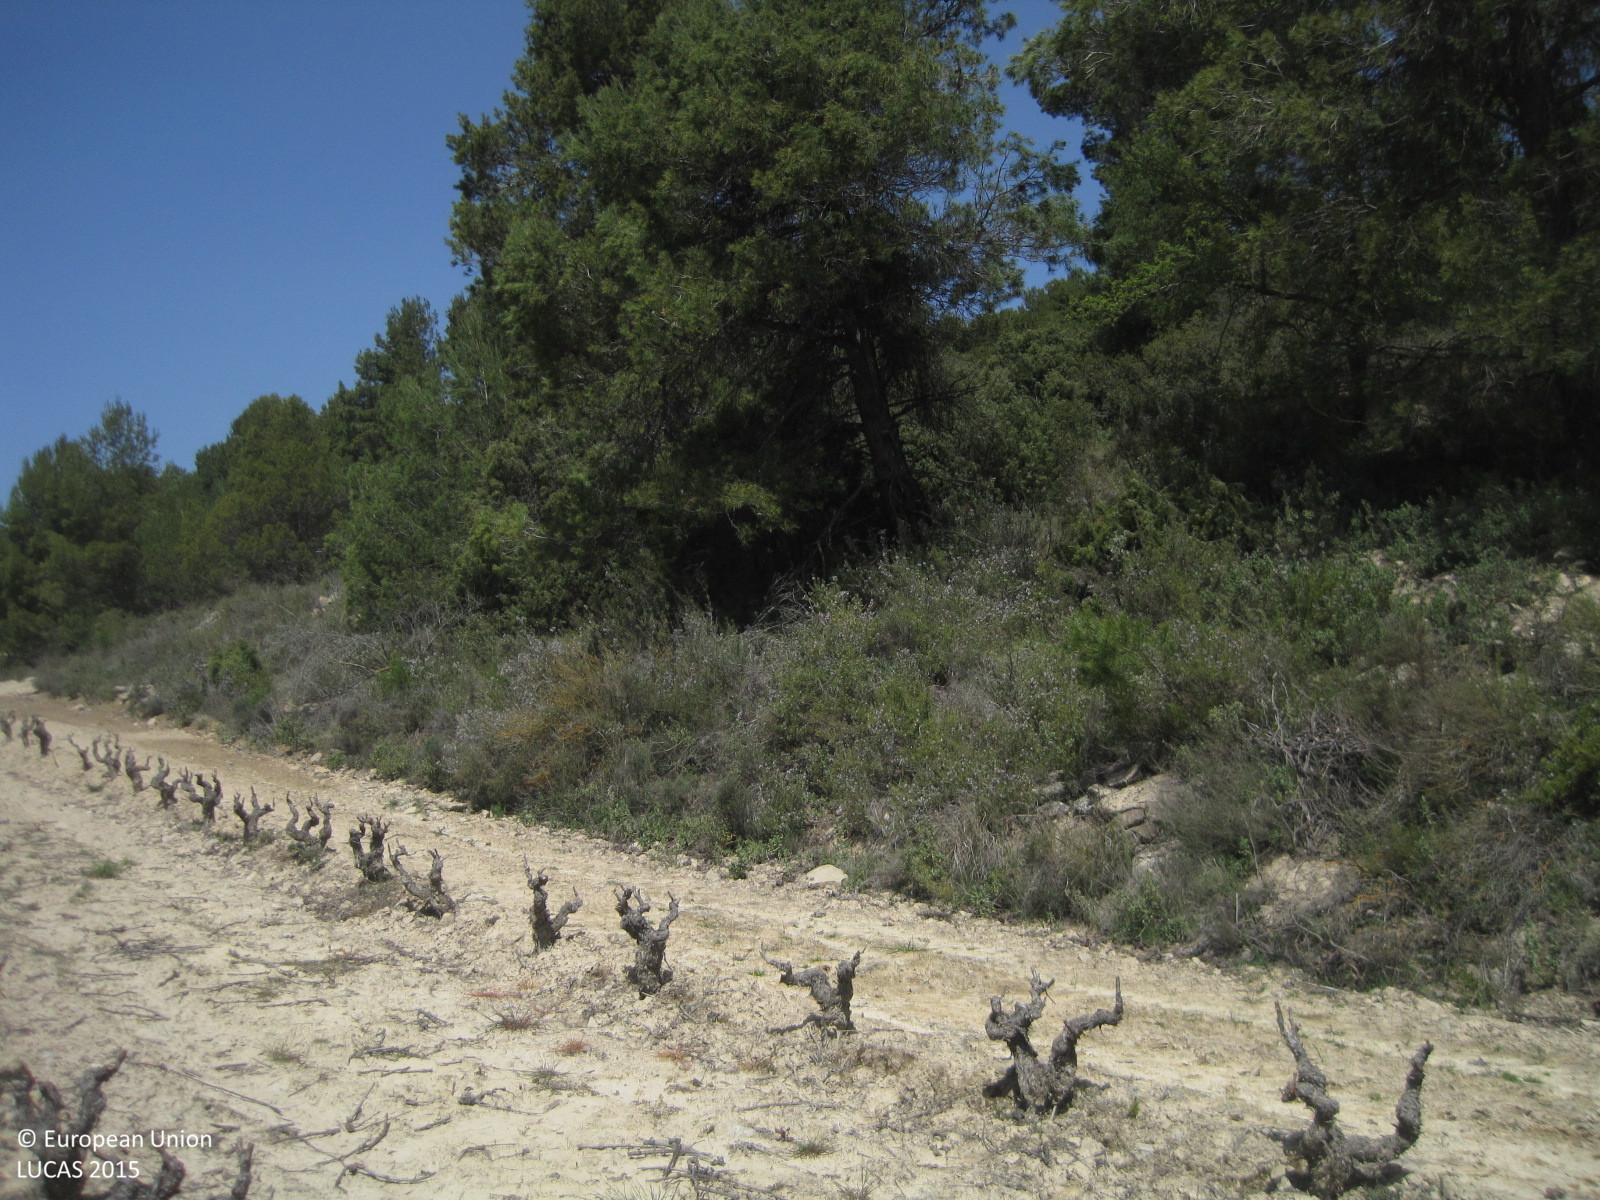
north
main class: Cropland
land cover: Vineyards
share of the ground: 25 - 50 %
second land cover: Other bare soil
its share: > 75 %
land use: Agriculture (excluding fallow land and kitchen gardens)
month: April
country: ES
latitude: 42.5630
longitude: -2.4088
